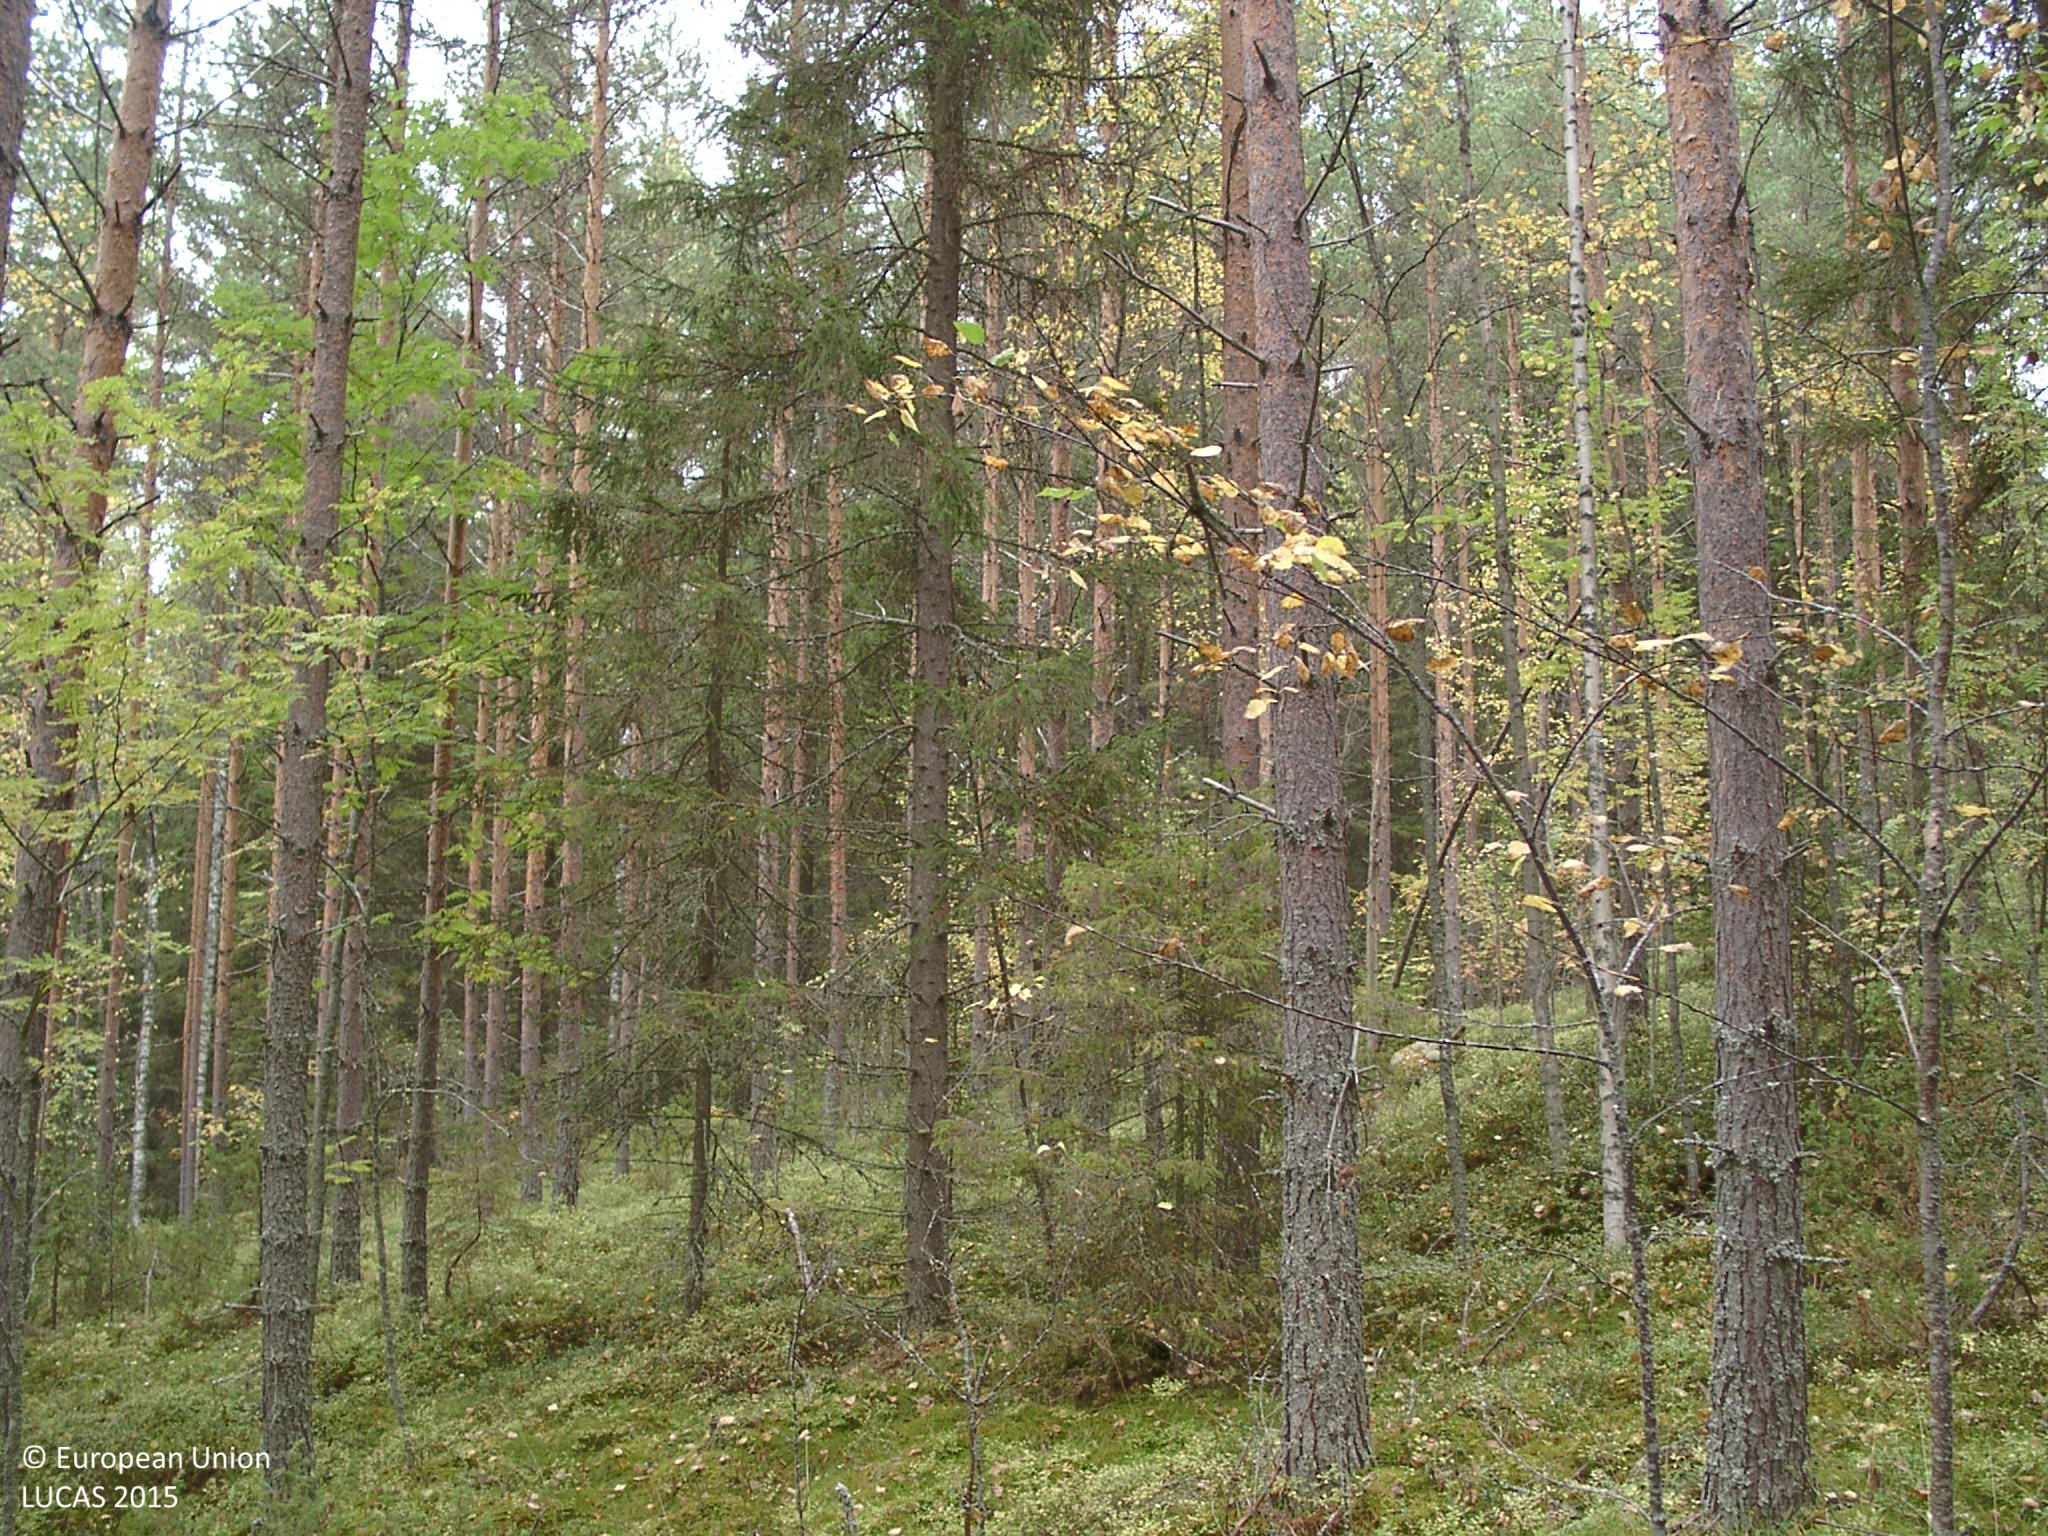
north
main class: Woodland
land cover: Pine dominated mixed woodland
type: boreal forest
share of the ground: 50 - 75 %
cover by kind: coniferous forest trees 50 %, broadleaved forest trees 20 %, shrubs 15 %, lichens and mosses 15 %
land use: Forestry
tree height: > 5 m
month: September
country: FI
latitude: 62.6973
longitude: 25.4088
